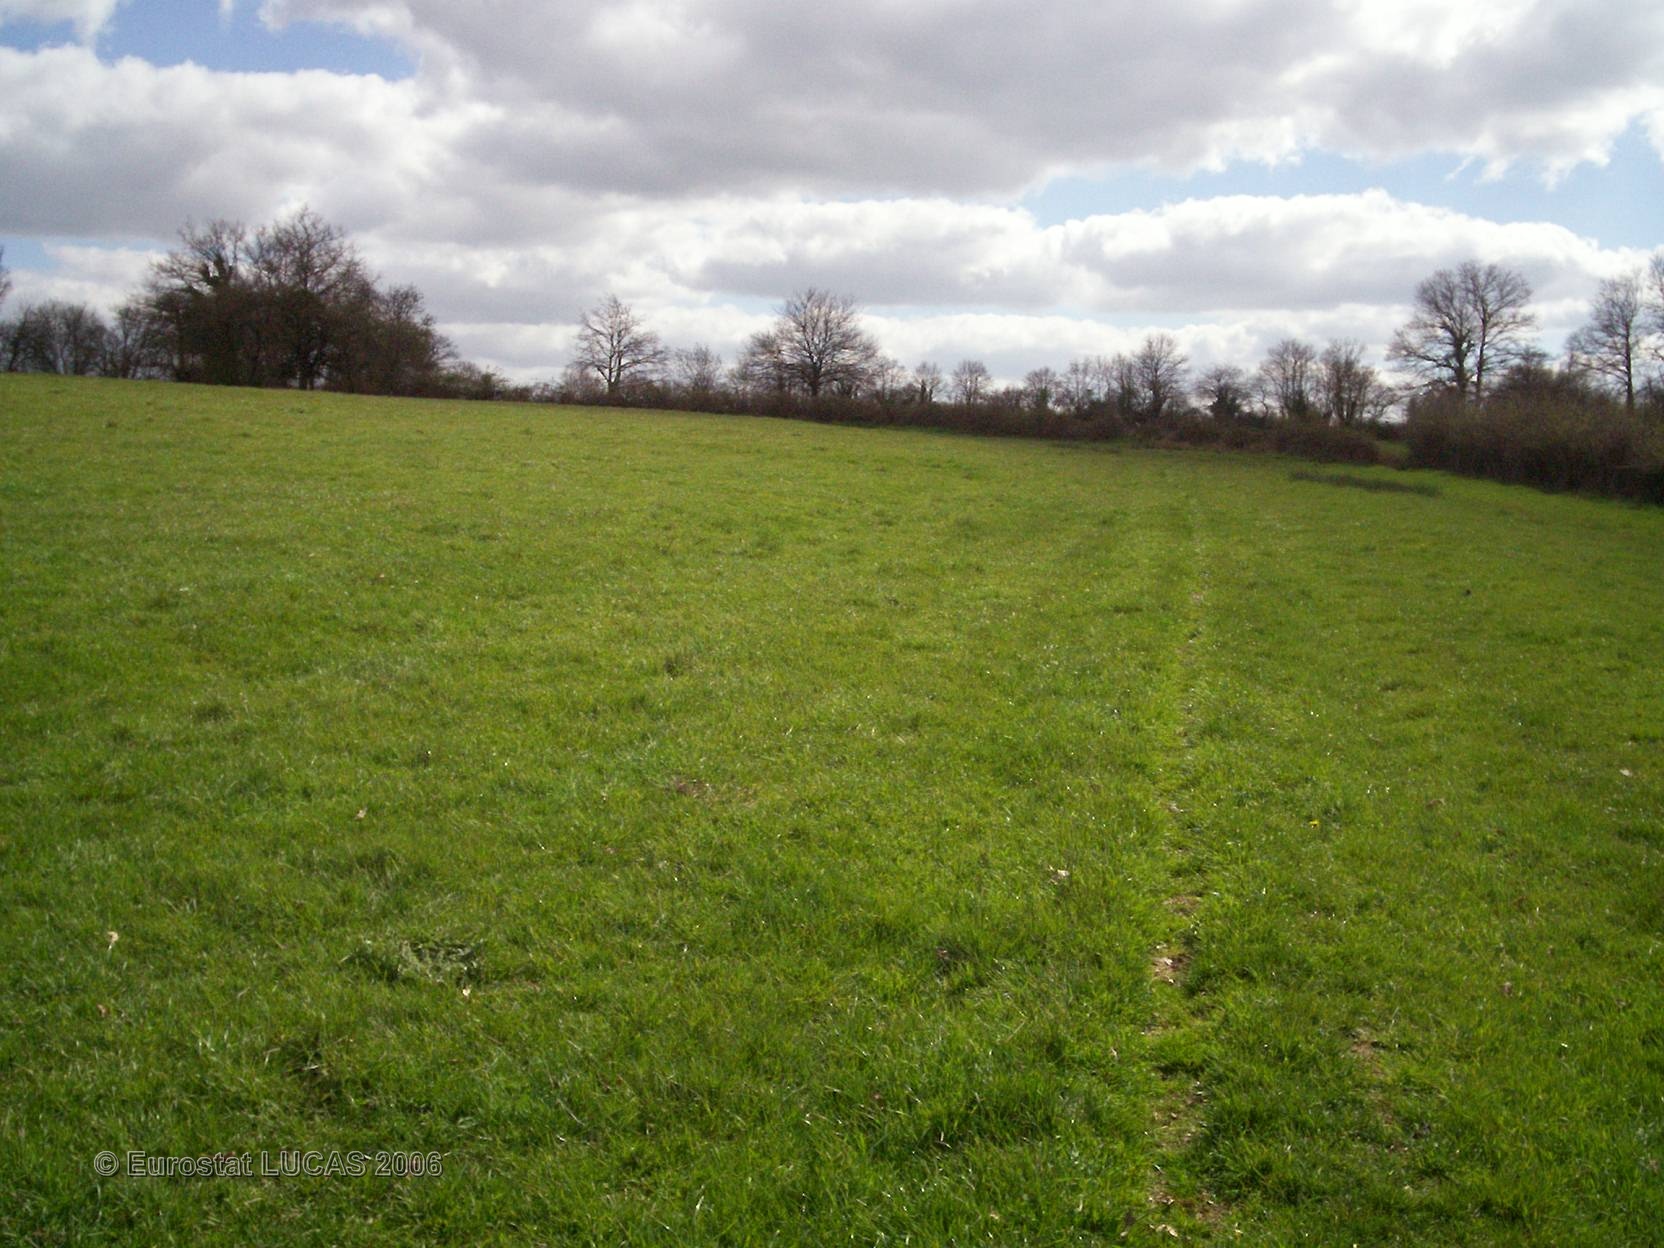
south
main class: Grassland
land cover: Grassland without tree/shrub cover
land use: Agriculture (excluding fallow land and kitchen gardens)
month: April
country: FR
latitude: 46.7726
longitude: -0.3589
